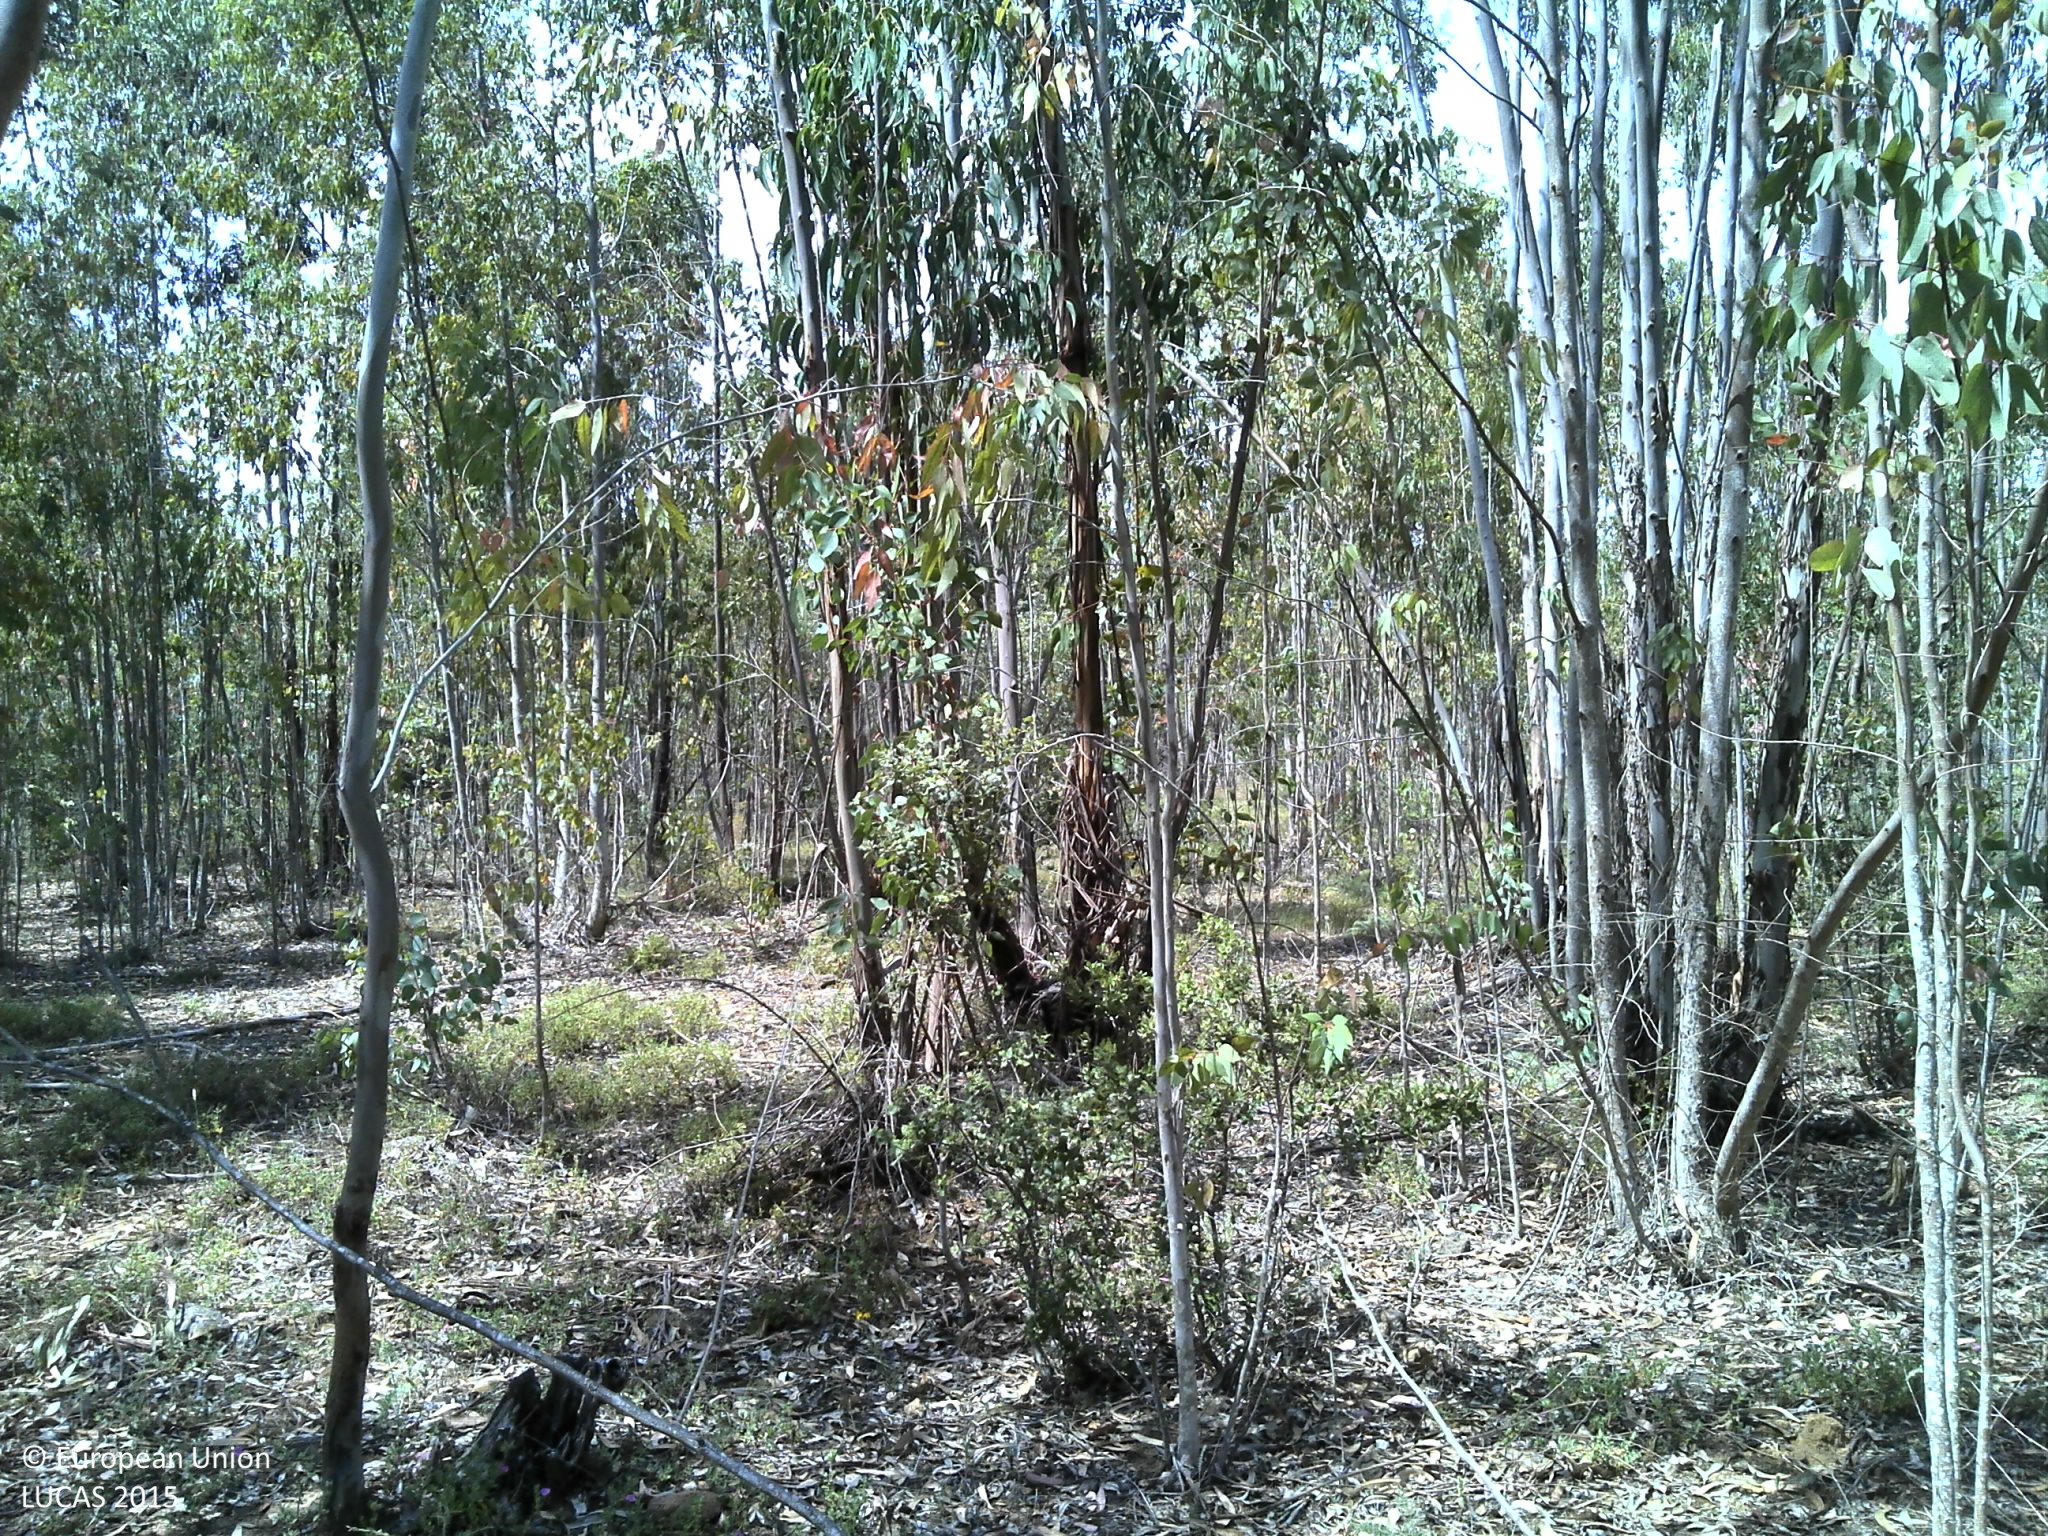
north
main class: Woodland
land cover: Broadleaved woodland
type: exotic forest
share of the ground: 50 - 75 %
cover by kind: broadleaved forest trees 75 %, herbaceous plants 10 %, unconsolidated bare surface 10 %, shrubs 5 %
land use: Forestry
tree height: > 5 m
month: May
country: PT
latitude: 39.1609
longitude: -7.5992
